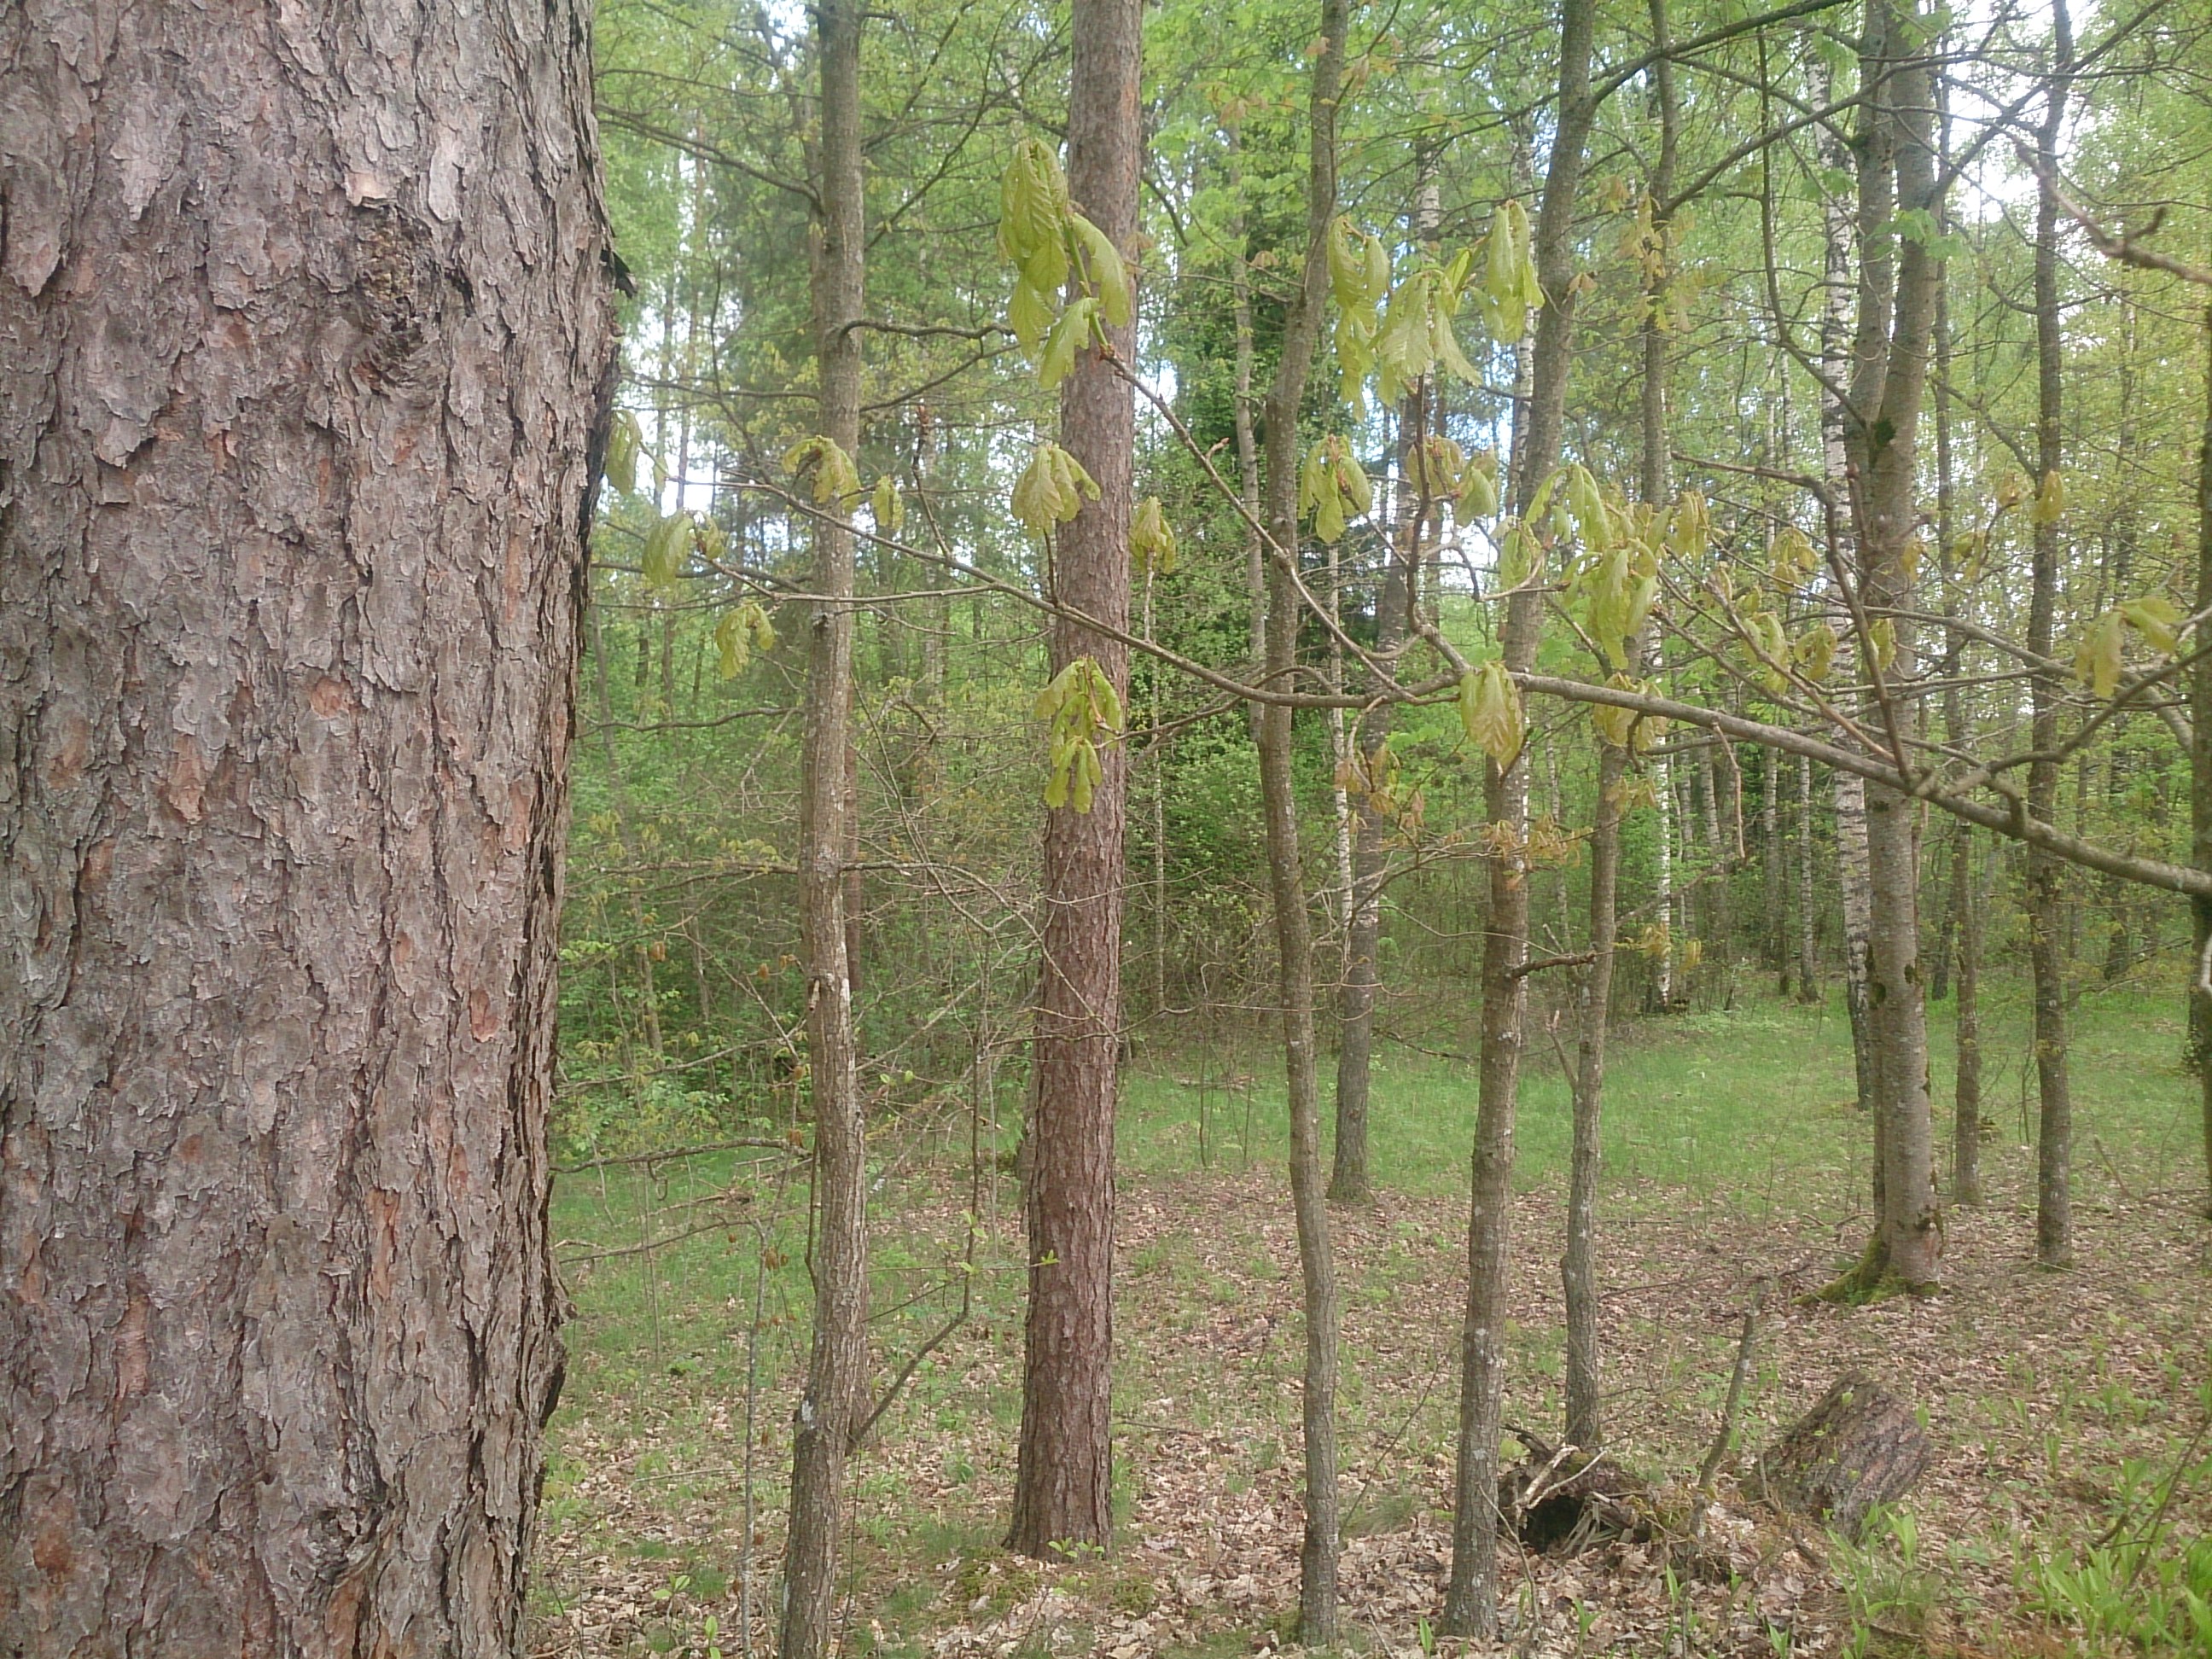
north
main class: Woodland
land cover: Pine dominated mixed woodland
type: hemiboreal forest and nemoral coniferous forest and mixed broadleaved-coniferous forest
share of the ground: > 75 %
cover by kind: coniferous forest trees 60 %, broadleaved forest trees 25 %, herbaceous plants 10 %, lichens and mosses 5 %
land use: Forestry
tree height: > 5 m
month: May
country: LV
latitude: 56.6689
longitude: 24.2371
